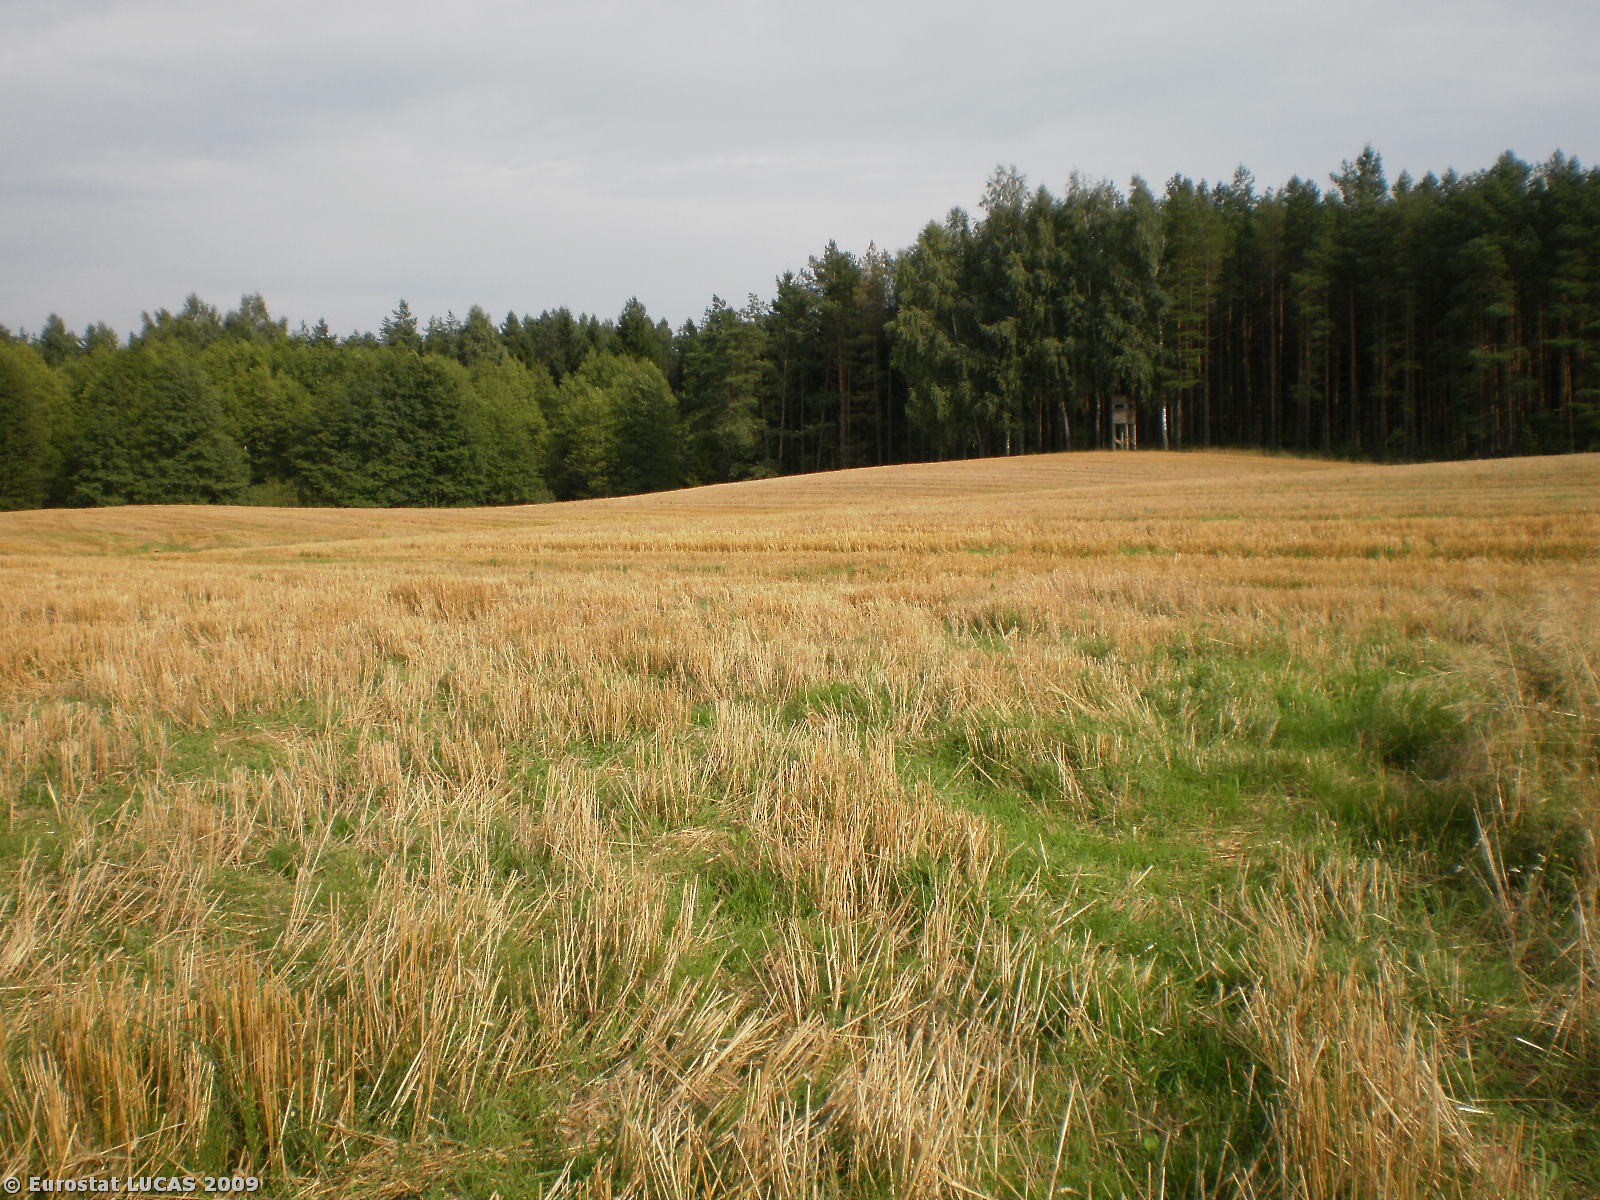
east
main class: Cropland
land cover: Triticale
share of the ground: < 10 %
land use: Agriculture (excluding fallow land and kitchen gardens)
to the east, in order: Triticale; Broadleaved woodland
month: September
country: PL
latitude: 53.9281
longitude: 21.4557
